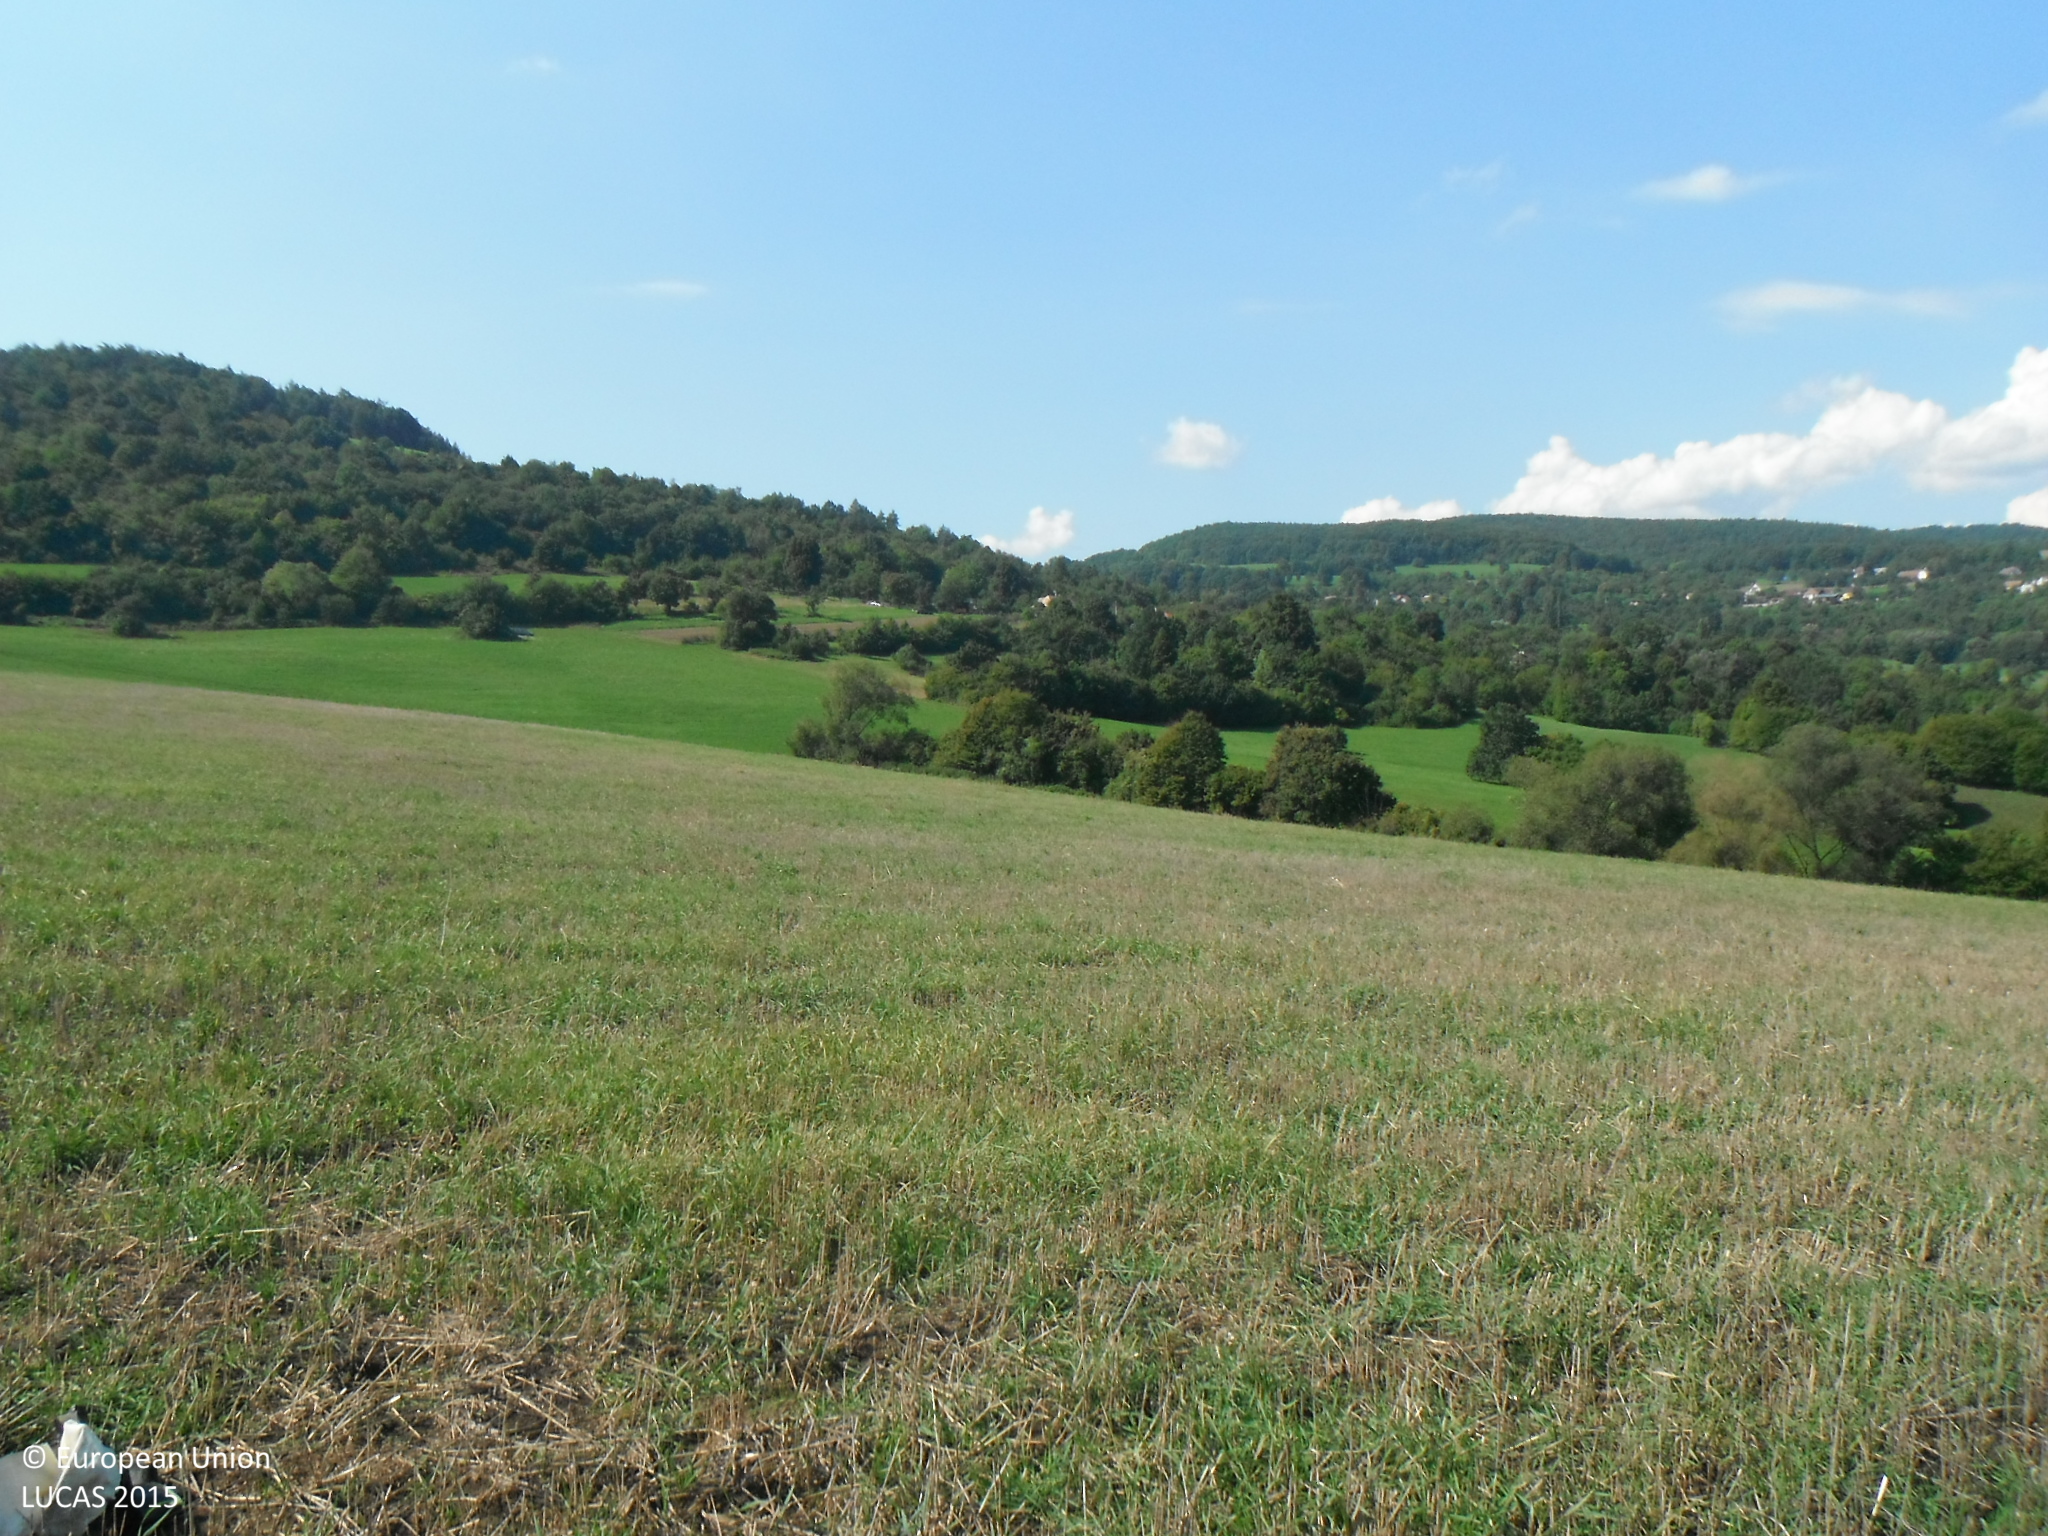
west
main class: Cropland
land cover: Common wheat
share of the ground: < 10 %
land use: Agriculture (excluding fallow land and kitchen gardens)
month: September
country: SK
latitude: 48.9428
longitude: 18.0289
